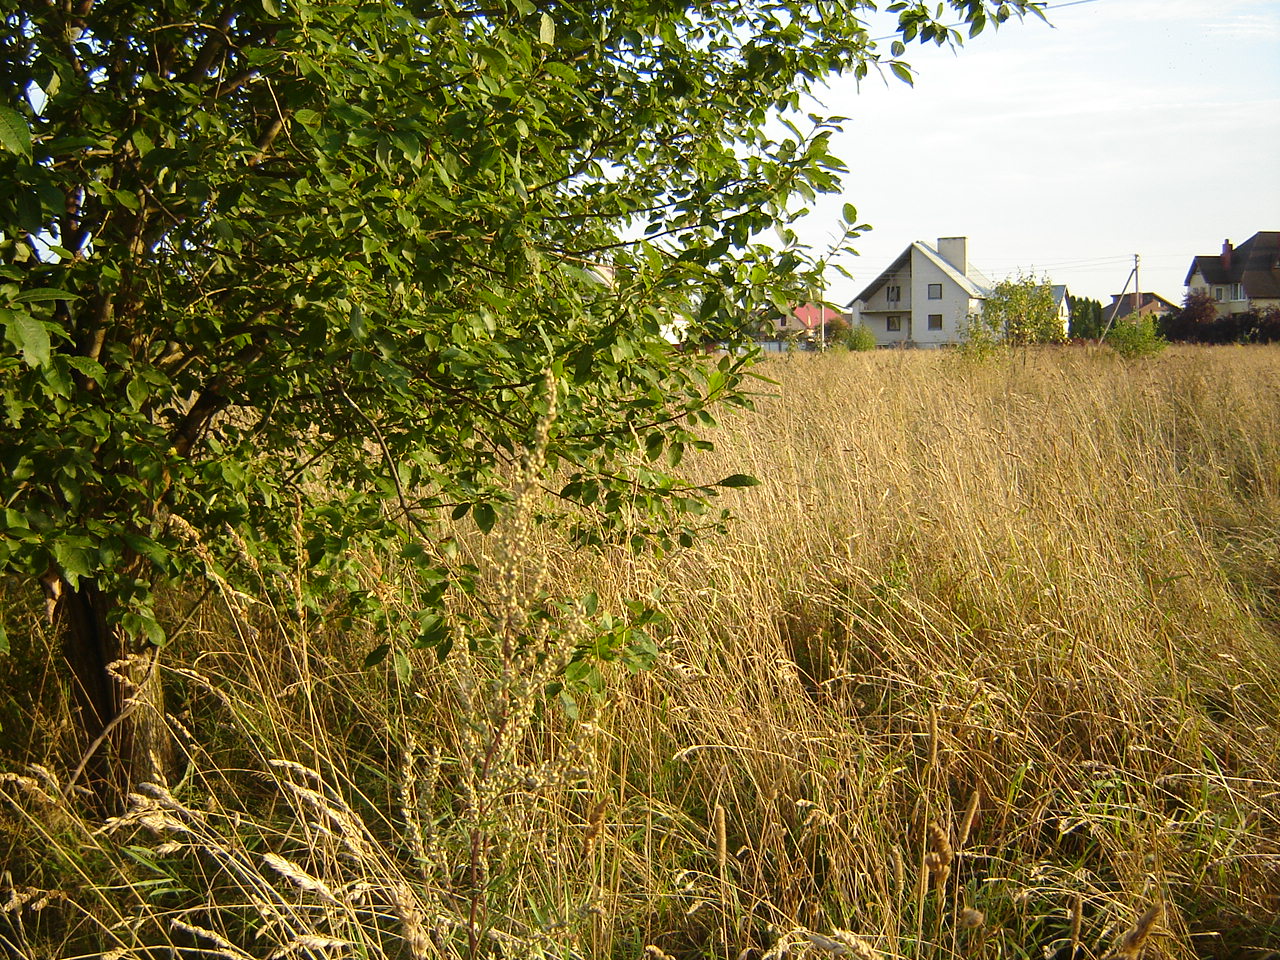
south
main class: Grassland
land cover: Grassland with sparse tree/shrub cover
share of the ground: > 75 %
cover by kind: herbaceous plants 95 %, broadleaved forest trees 5 %
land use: Fallow land
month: August
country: LT
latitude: 54.5812
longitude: 25.1732
